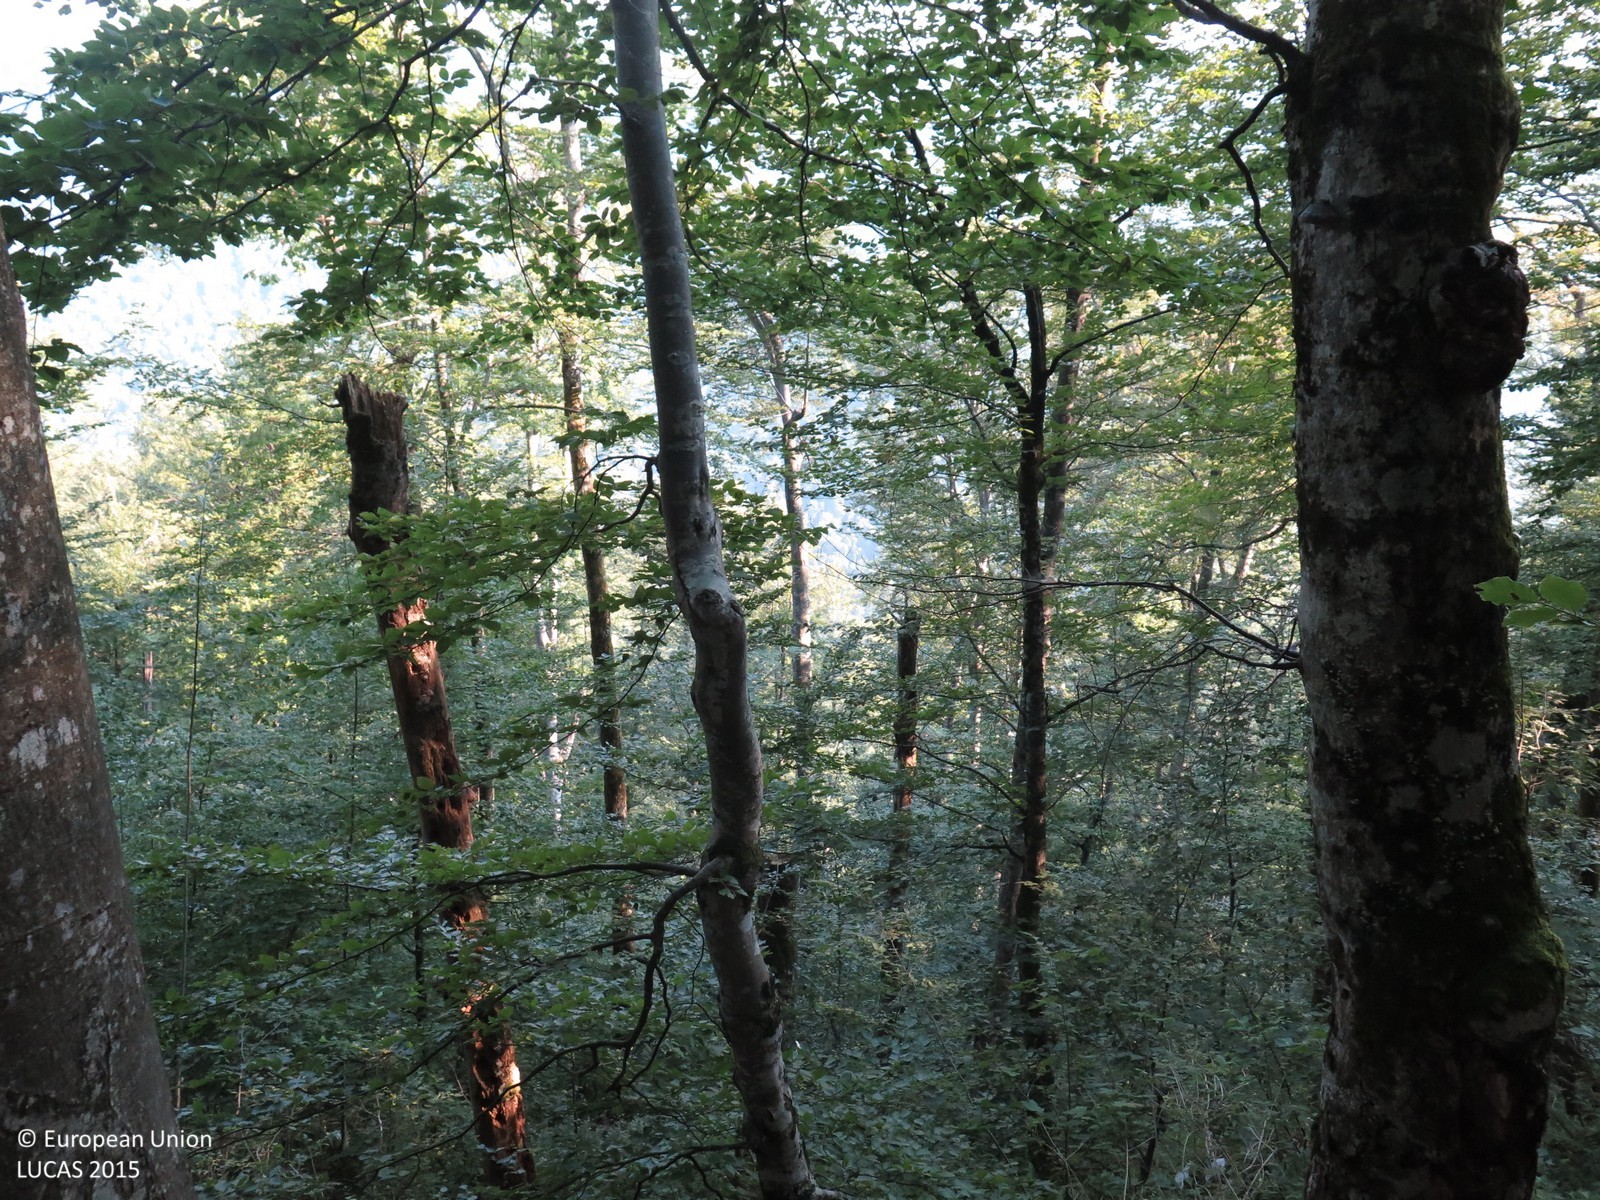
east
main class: Woodland
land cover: Broadleaved woodland
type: mountainous beech forest
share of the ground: > 75 %
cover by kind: broadleaved forest trees 90 %, herbaceous plants 5 %, unconsolidated bare surface 5 %
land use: Forestry
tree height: > 5 m
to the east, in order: Broadleaved woodland
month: August
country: HR
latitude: 45.4943
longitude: 14.9990
